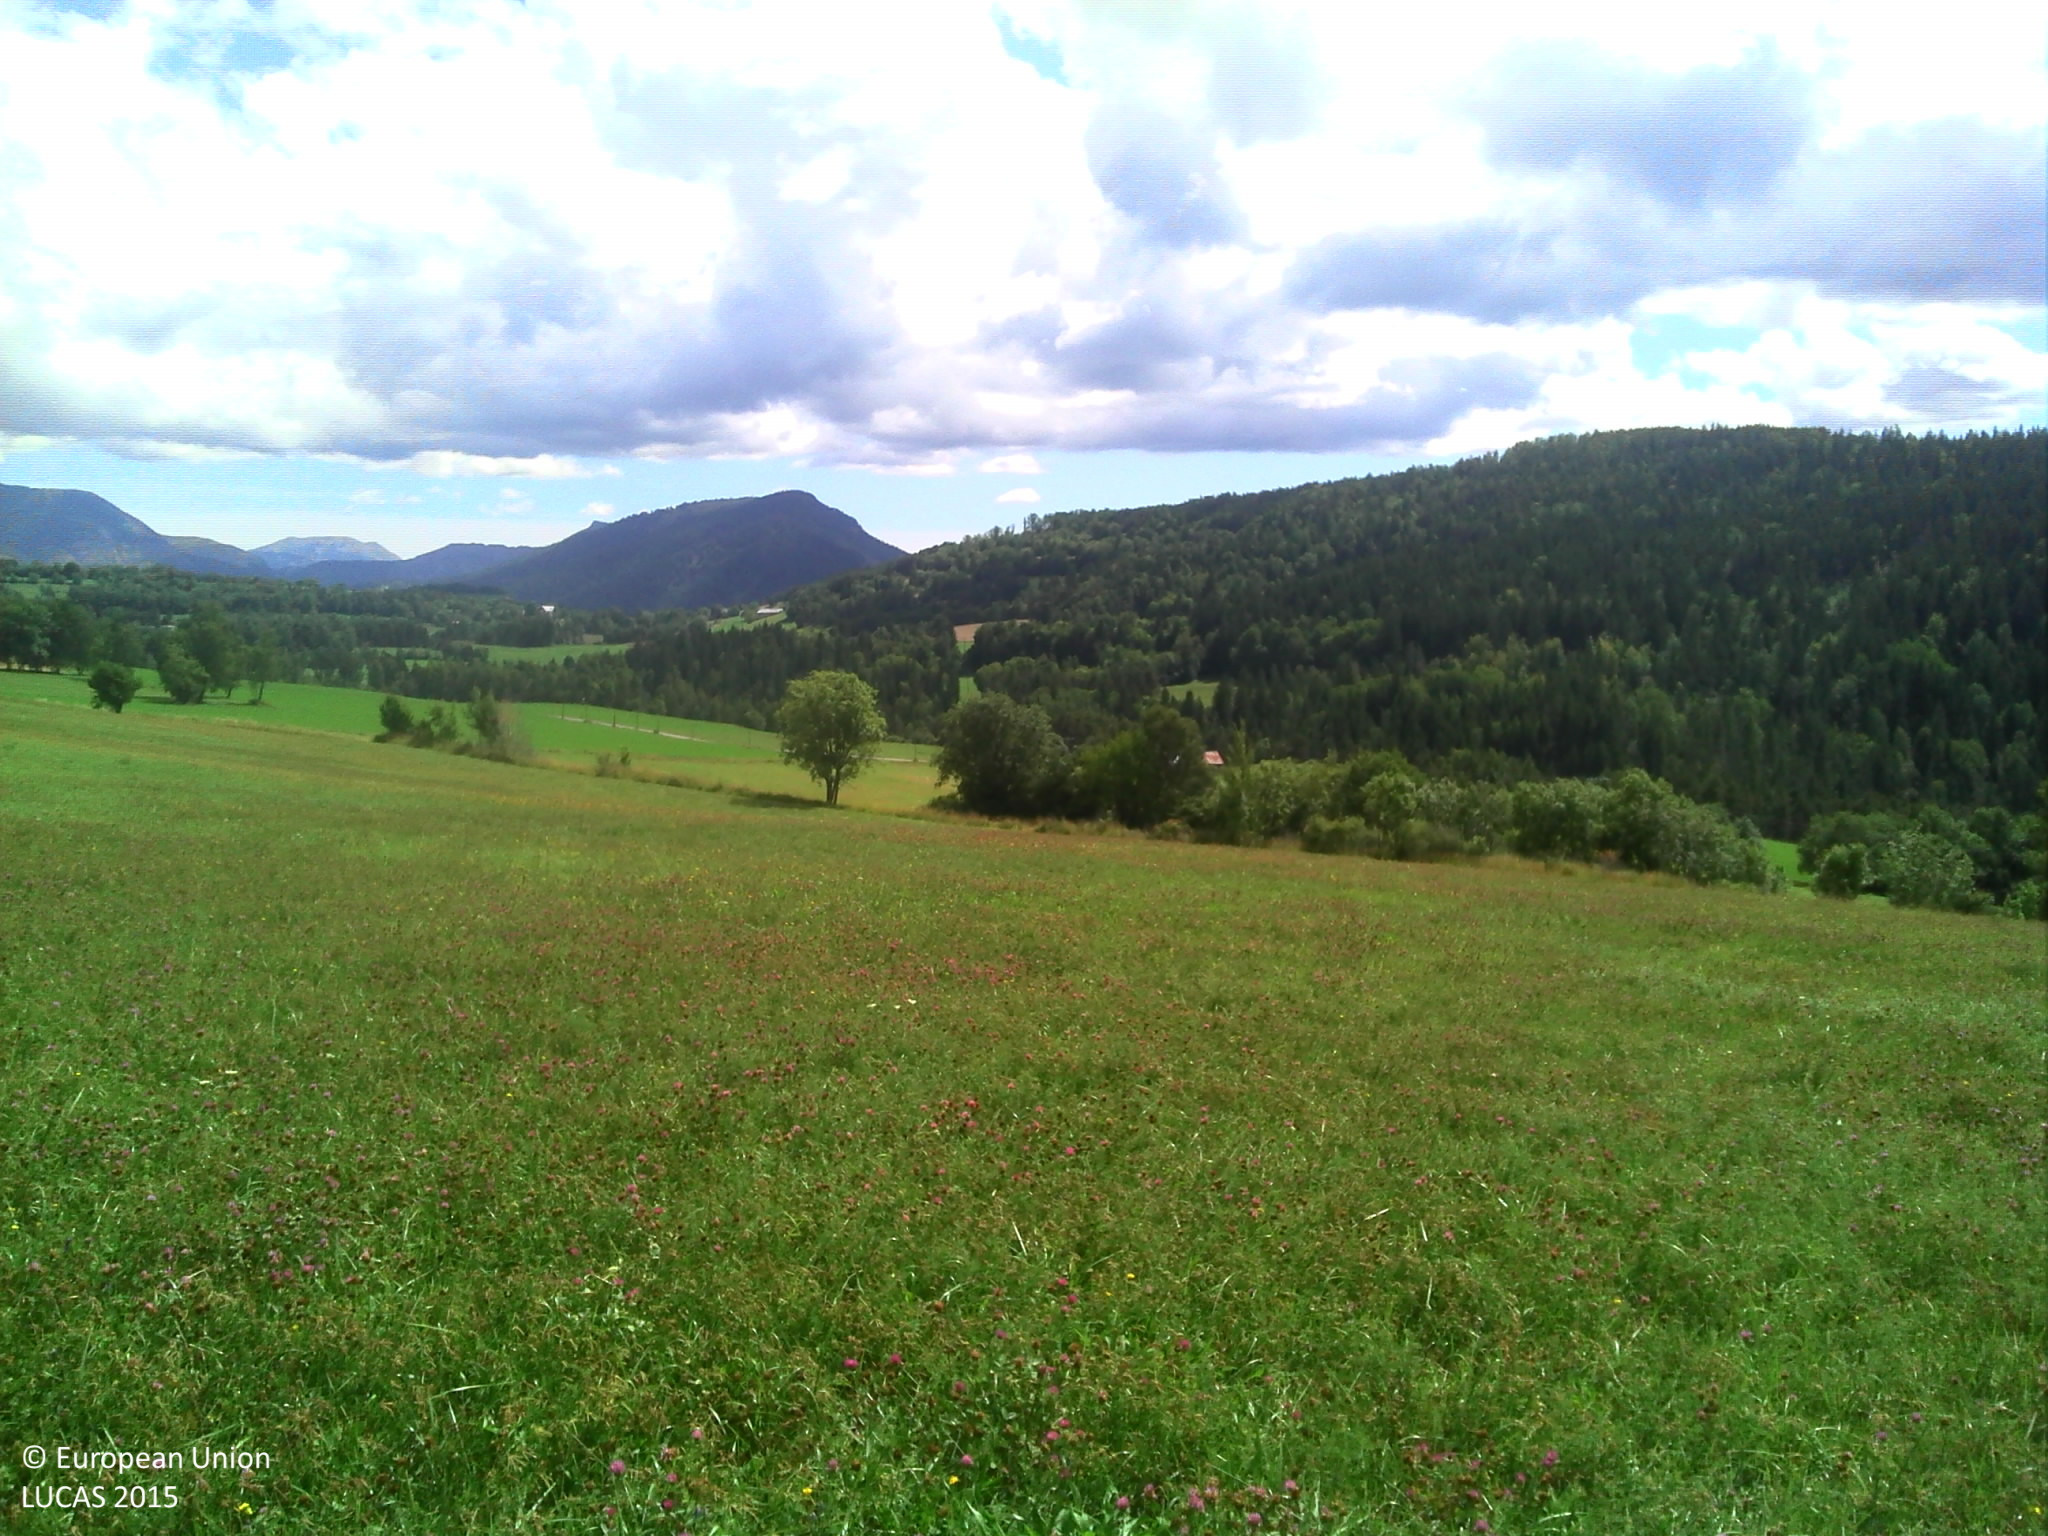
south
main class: Grassland
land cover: Grassland without tree/shrub cover
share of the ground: > 75 %
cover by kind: herbaceous plants 100 %
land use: Agriculture (excluding fallow land and kitchen gardens)
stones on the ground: < 10 %
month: August
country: FR
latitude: 44.3768
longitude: 6.3546
